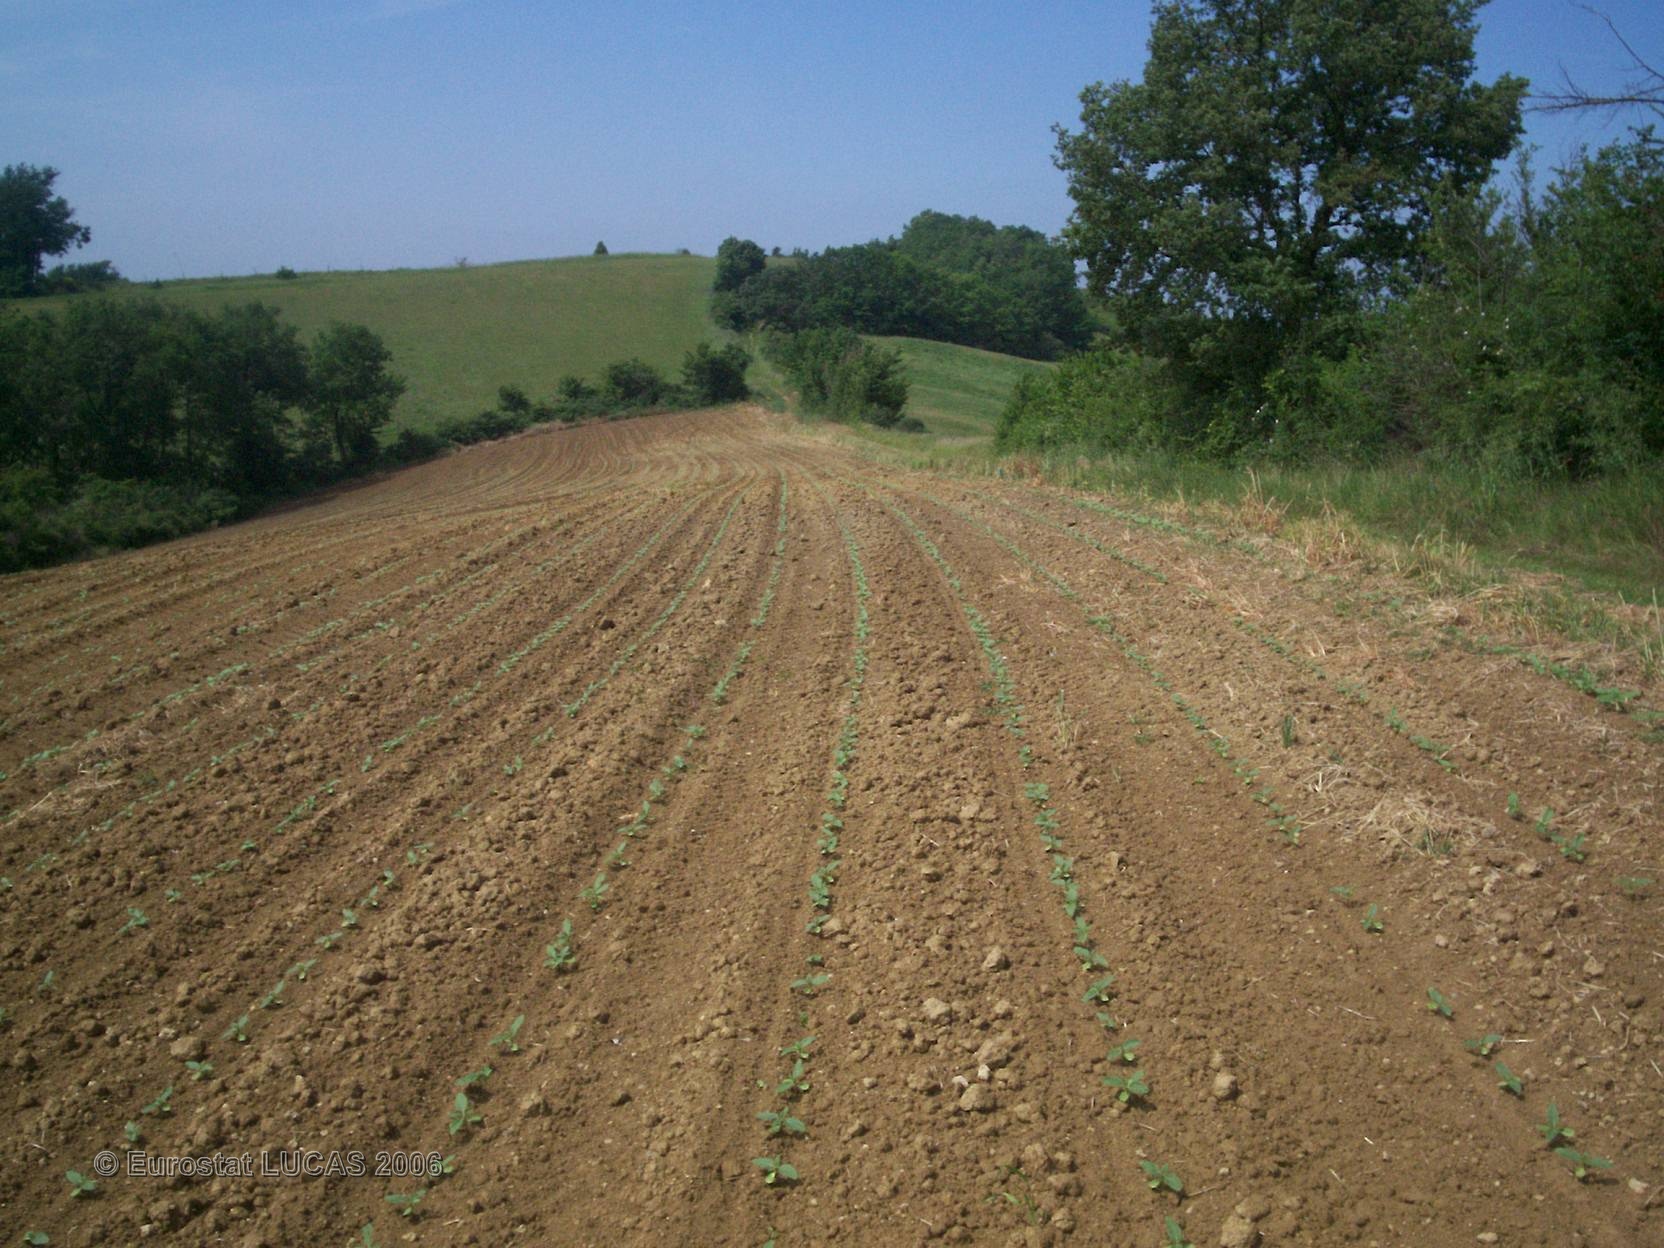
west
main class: Cropland
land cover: Soya
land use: Agriculture (excluding fallow land and kitchen gardens)
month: May
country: FR
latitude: 43.4751
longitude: 0.8646
